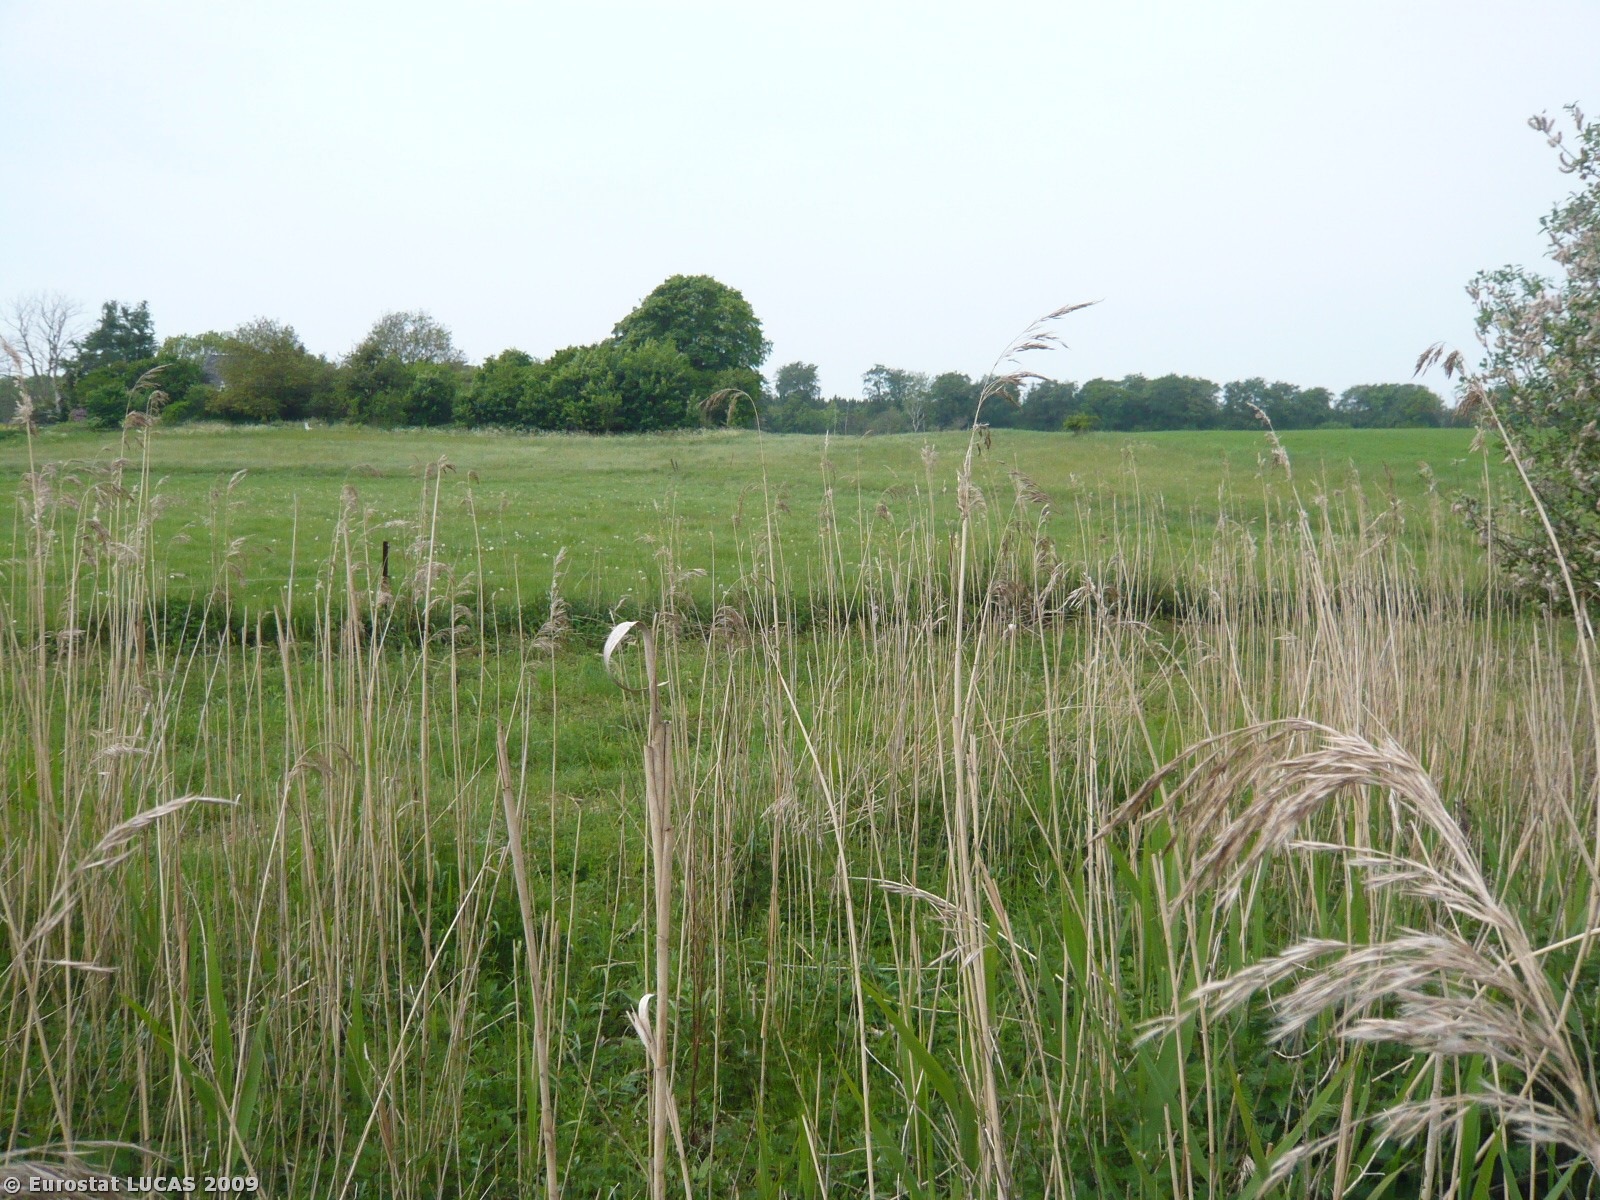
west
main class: Wetlands
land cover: Inland marshes
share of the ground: > 75 %
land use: Unused
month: May
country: DK
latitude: 55.2217
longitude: 11.8378
